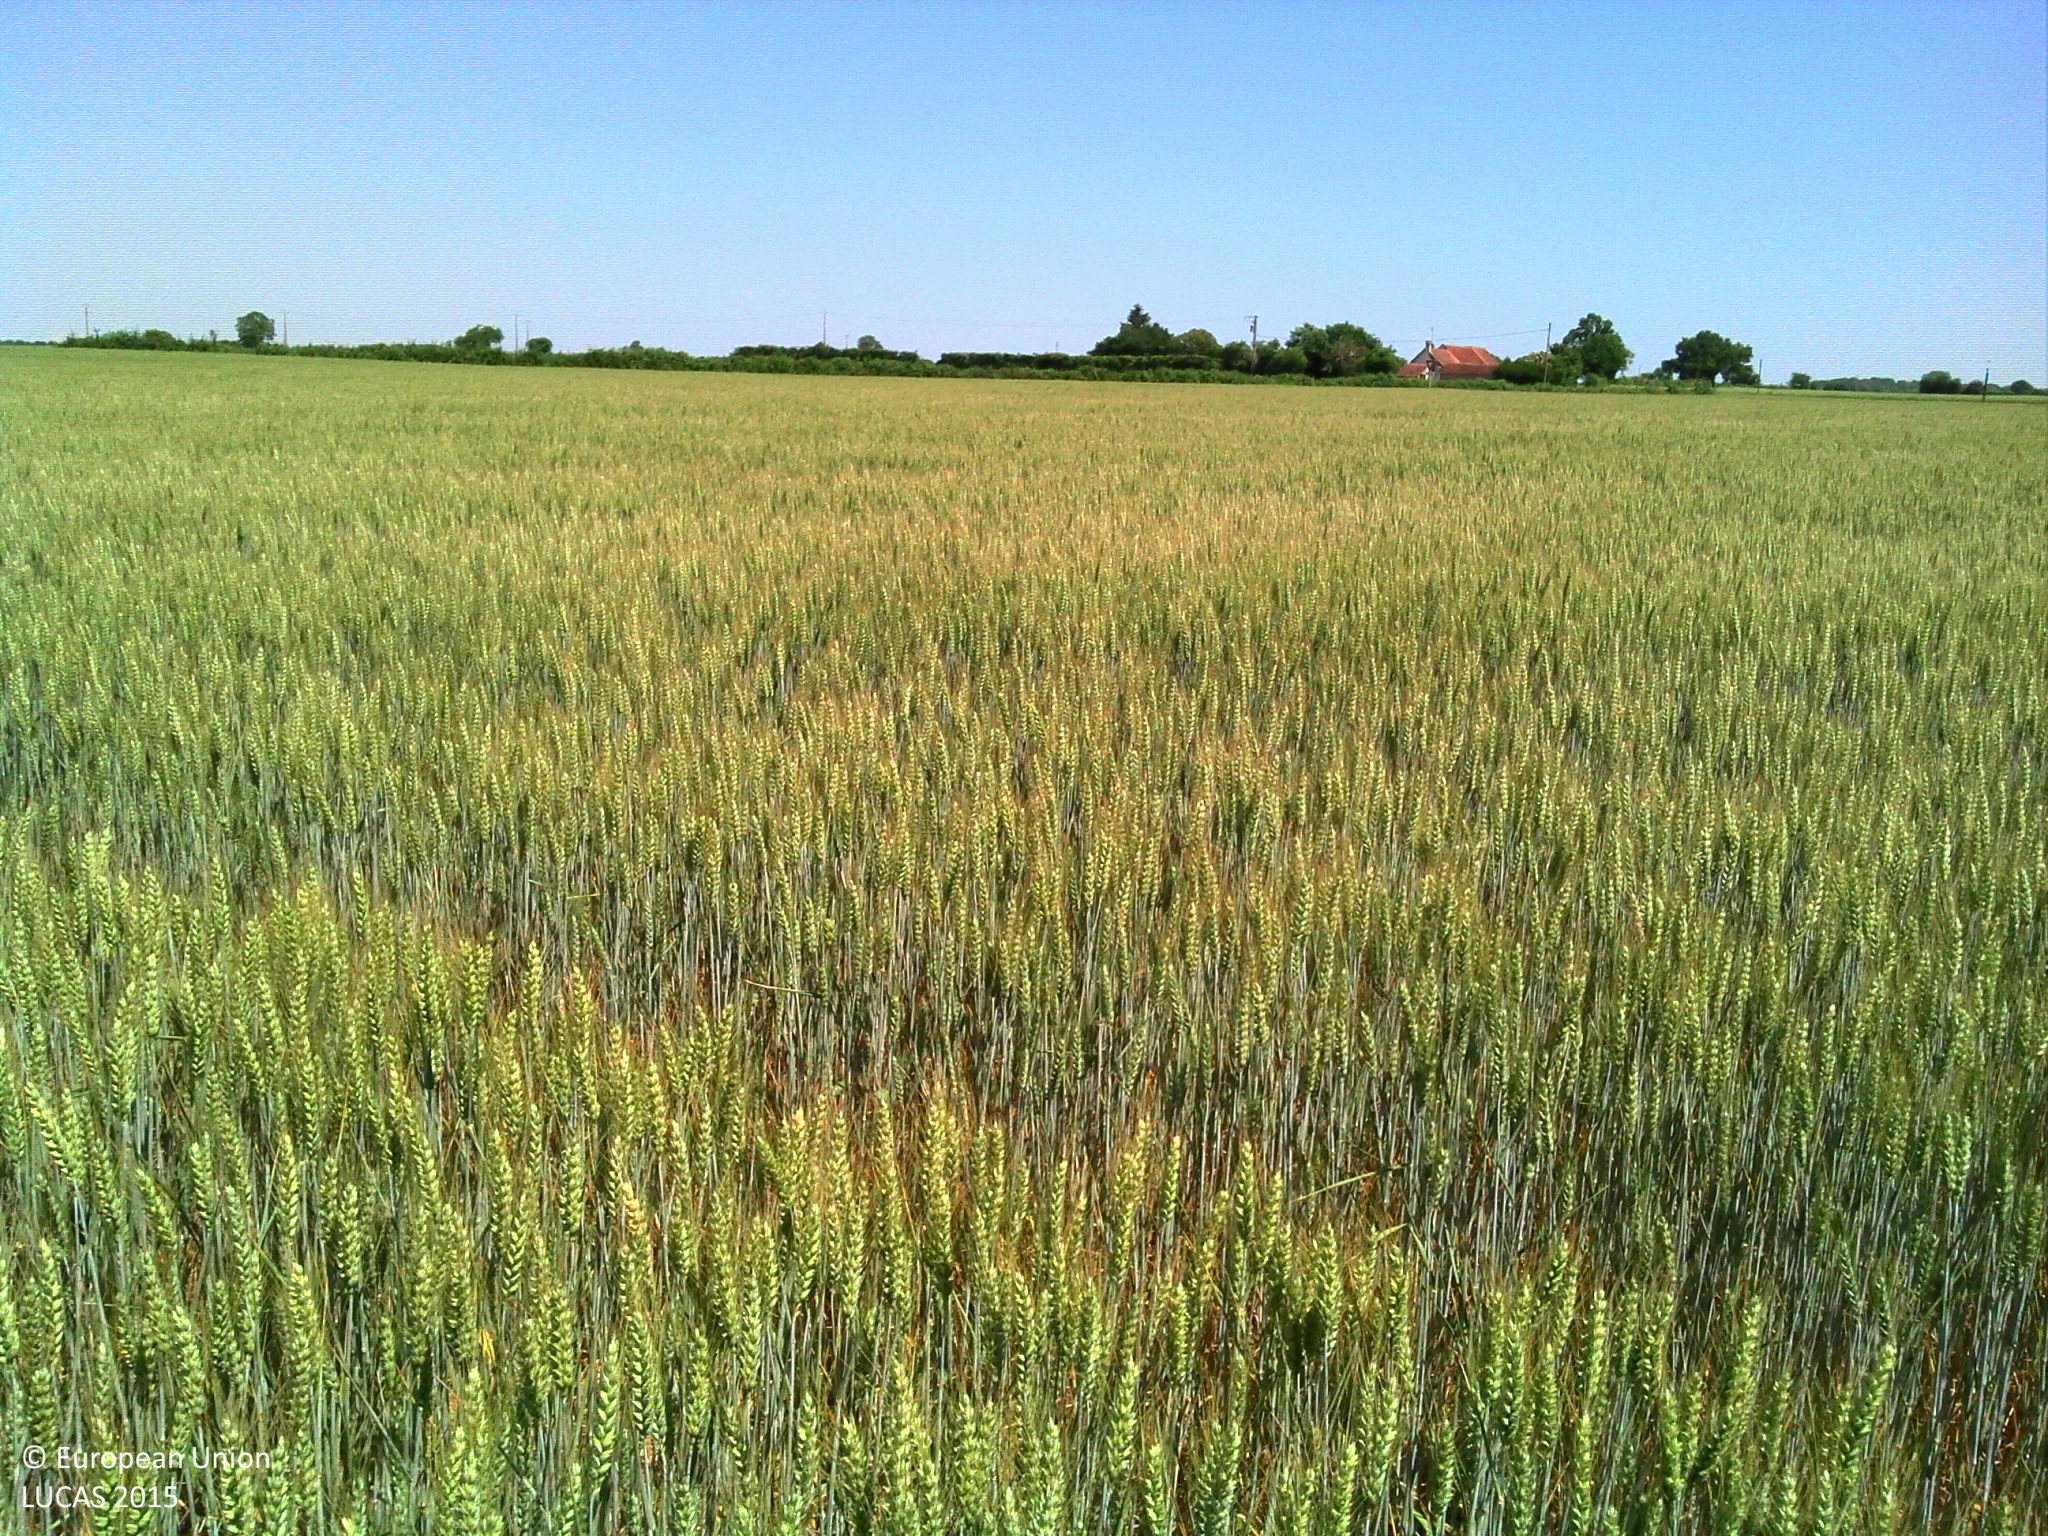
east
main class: Cropland
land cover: Common wheat
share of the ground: > 75 %
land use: Agriculture (excluding fallow land and kitchen gardens)
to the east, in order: Common wheat; Ditches and canals; Grass margins; Paved roads, cycling and walking lanes; Grass margins; Managed hedges; Common wheat
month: June
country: FR
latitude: 46.8798
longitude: 2.7122
